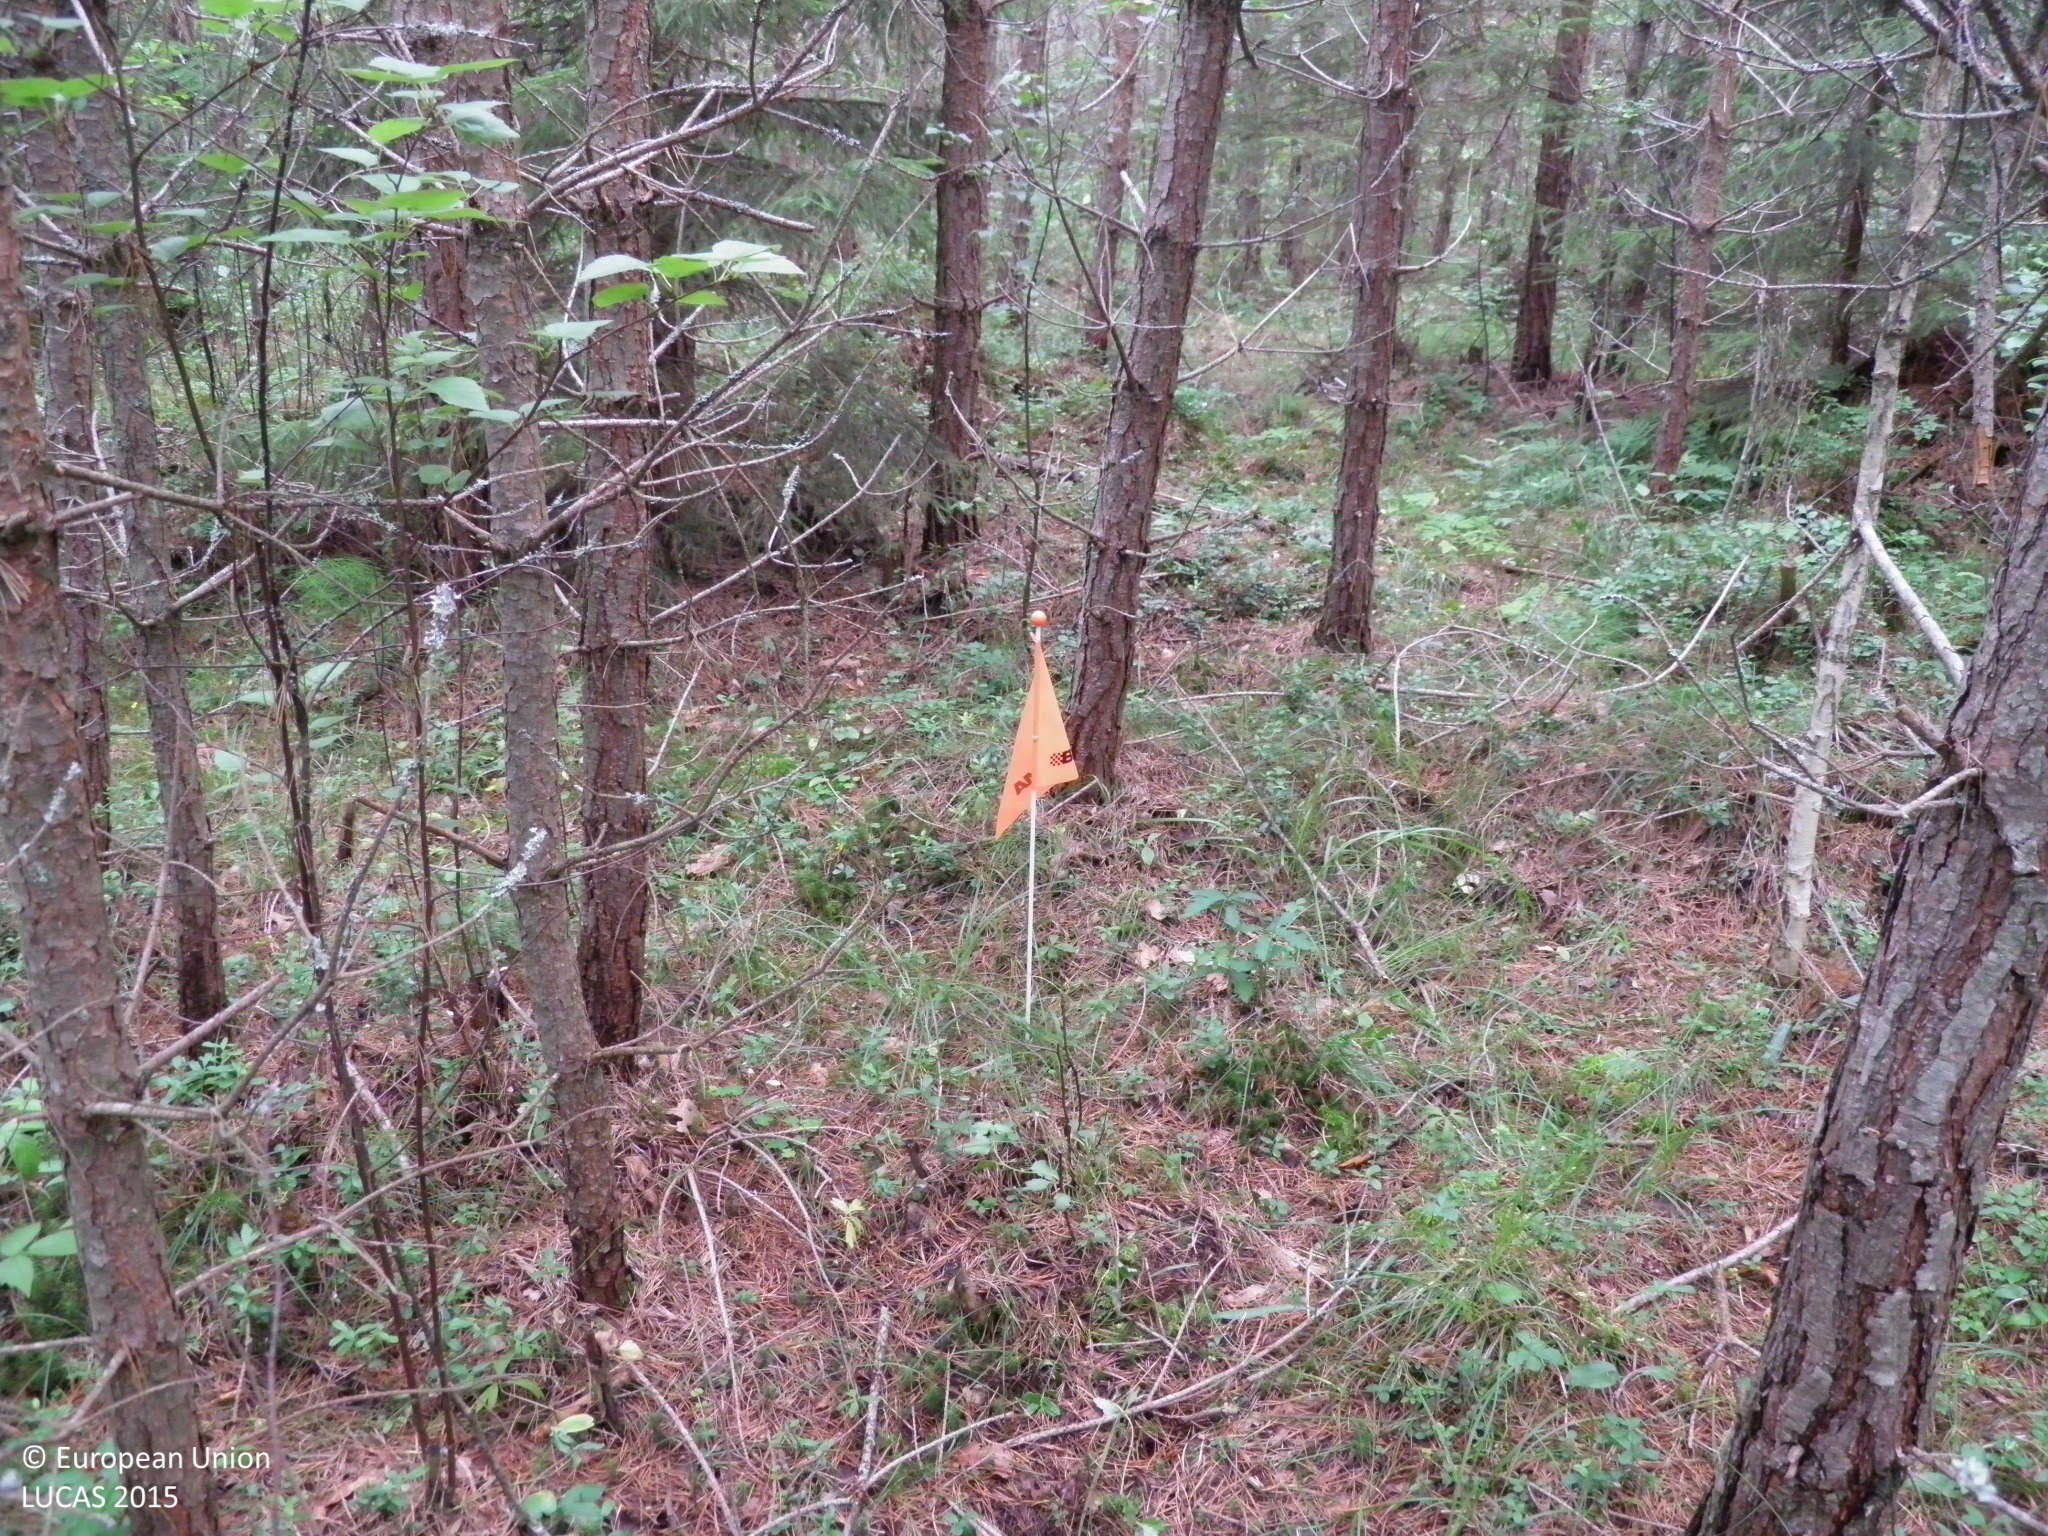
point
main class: Woodland
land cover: Pine dominated mixed woodland
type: hemiboreal forest and nemoral coniferous forest and mixed broadleaved-coniferous forest
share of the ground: > 75 %
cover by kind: coniferous forest trees 50 %, broadleaved forest trees 40 %, shrubs 5 %, herbaceous plants 5 %
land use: Forestry
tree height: > 5 m
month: July
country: FI
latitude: 60.1804
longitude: 22.7867
